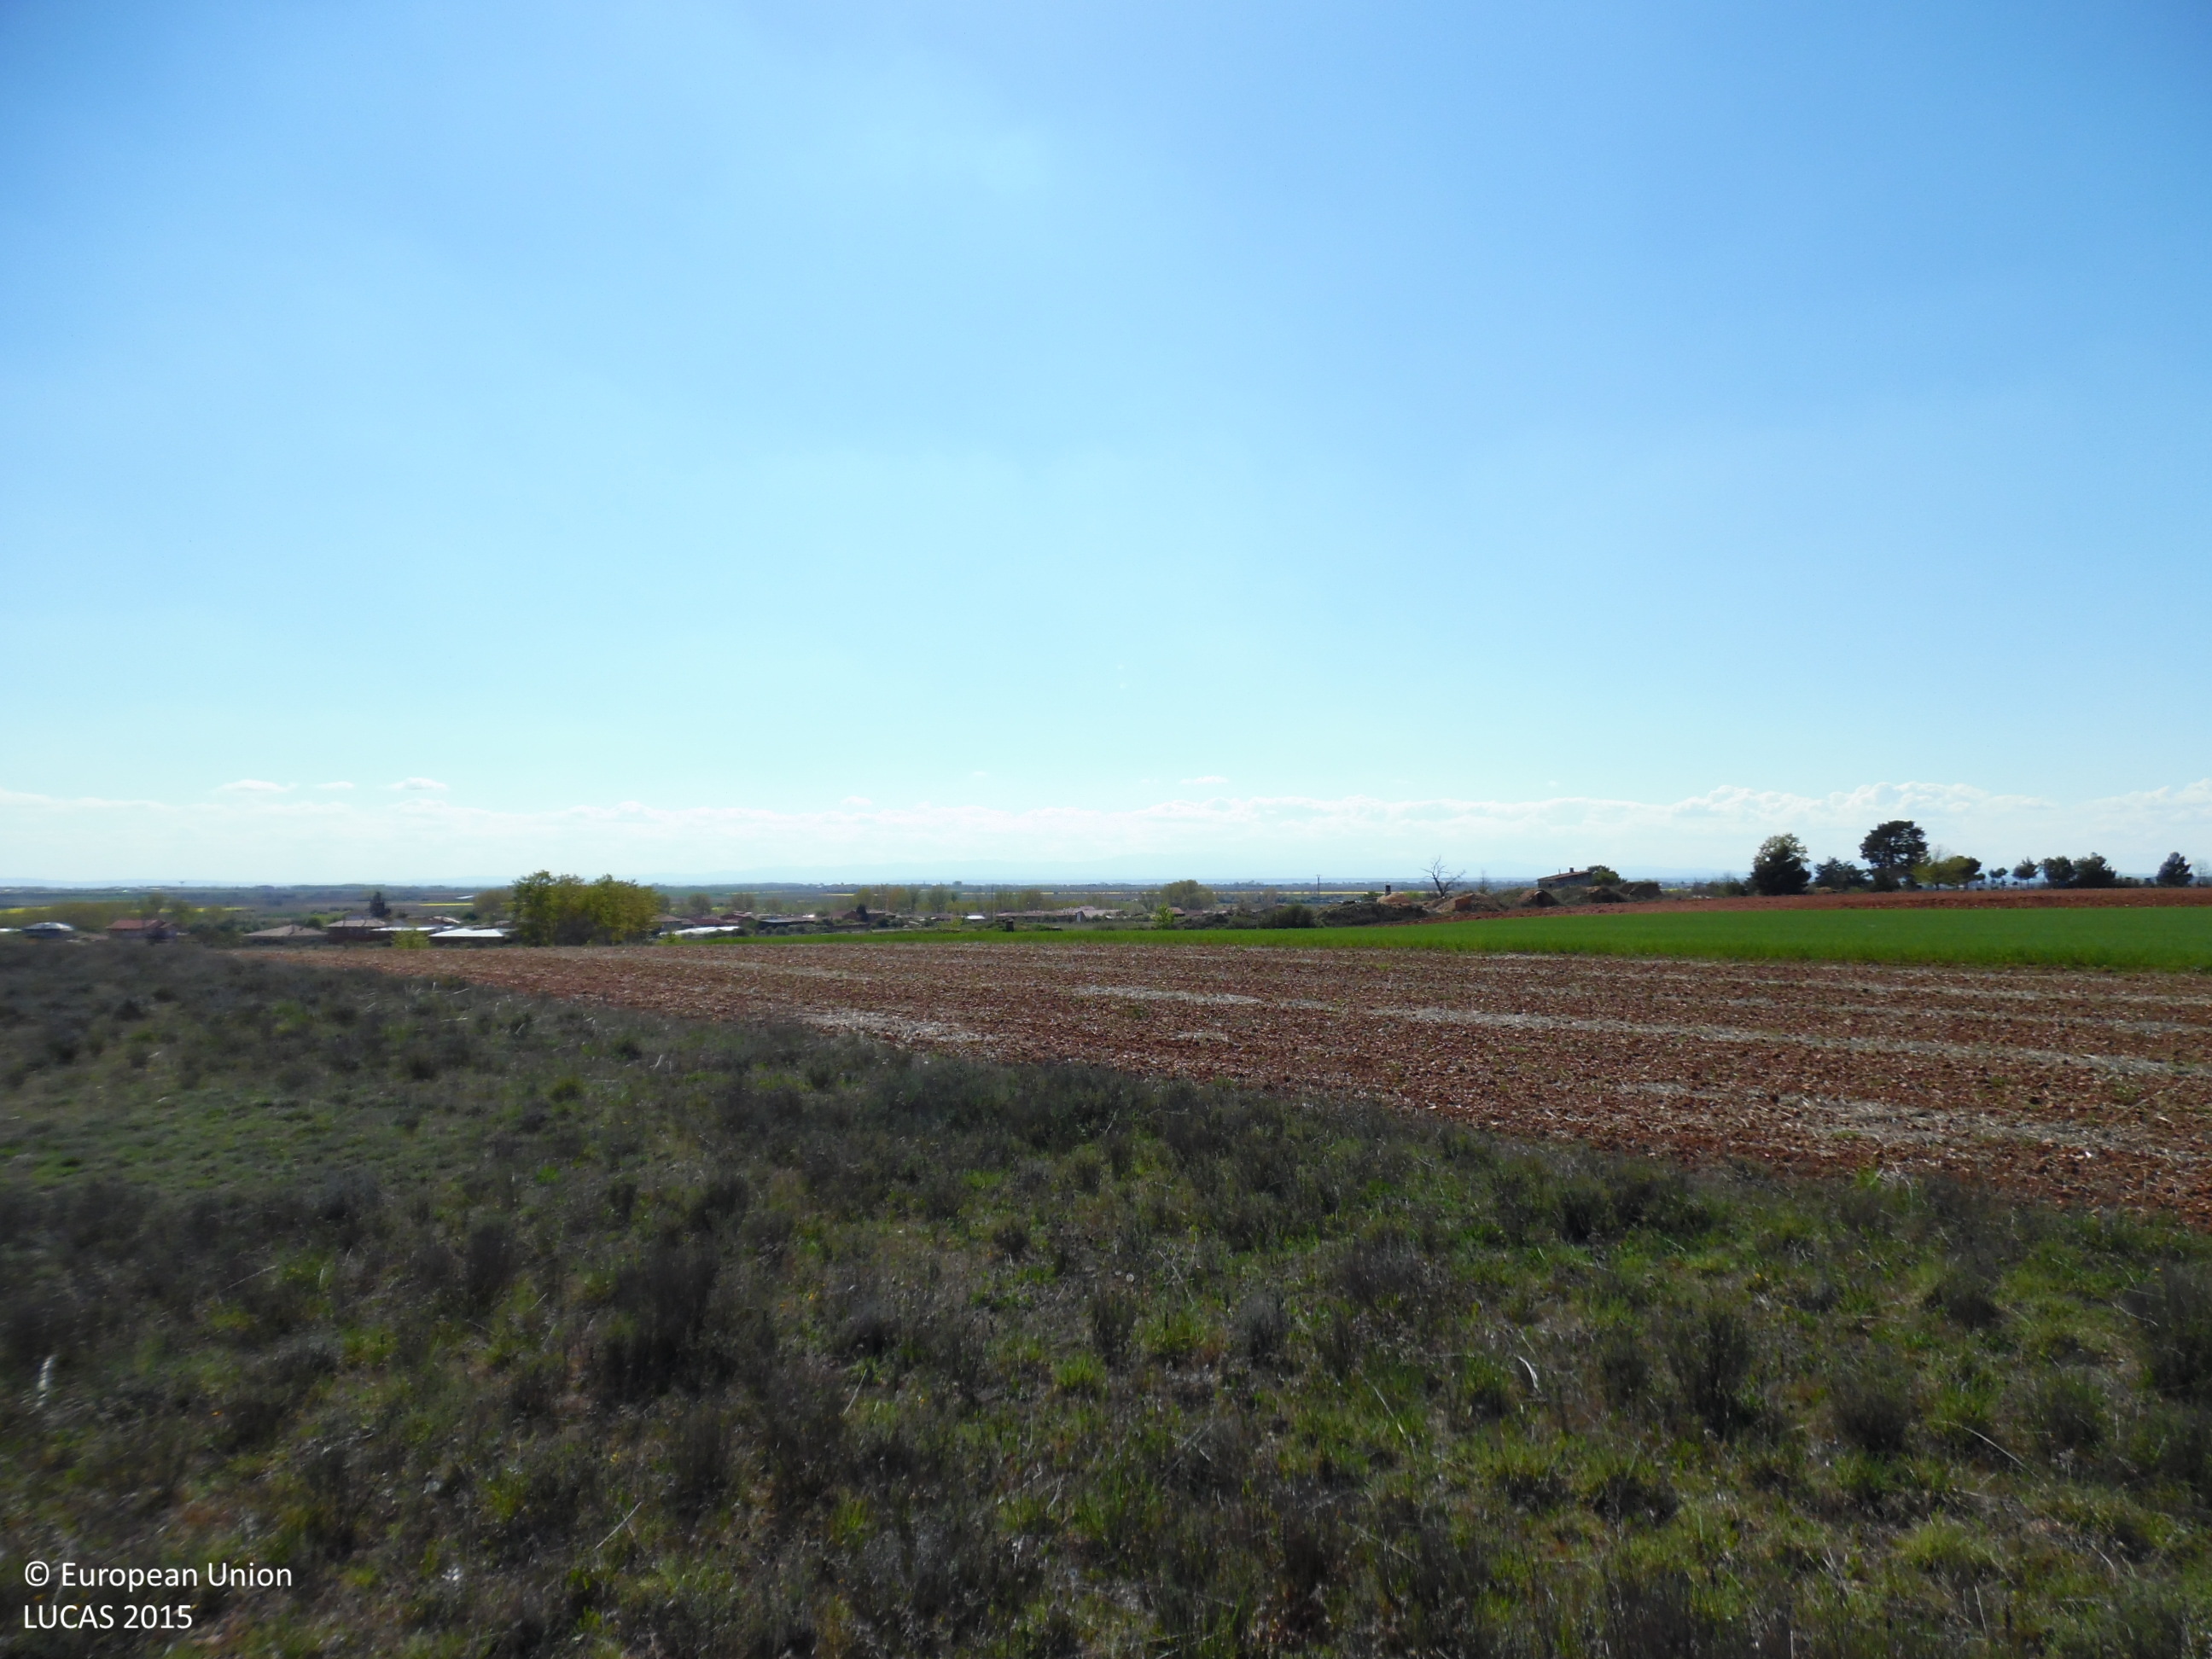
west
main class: Shrubland
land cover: Shrubland without tree cover
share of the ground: 50 - 75 %
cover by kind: shrubs 60 %, herbaceous plants 40 %
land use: Abandoned areas
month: April
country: ES
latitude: 42.5236
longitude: -5.6925
